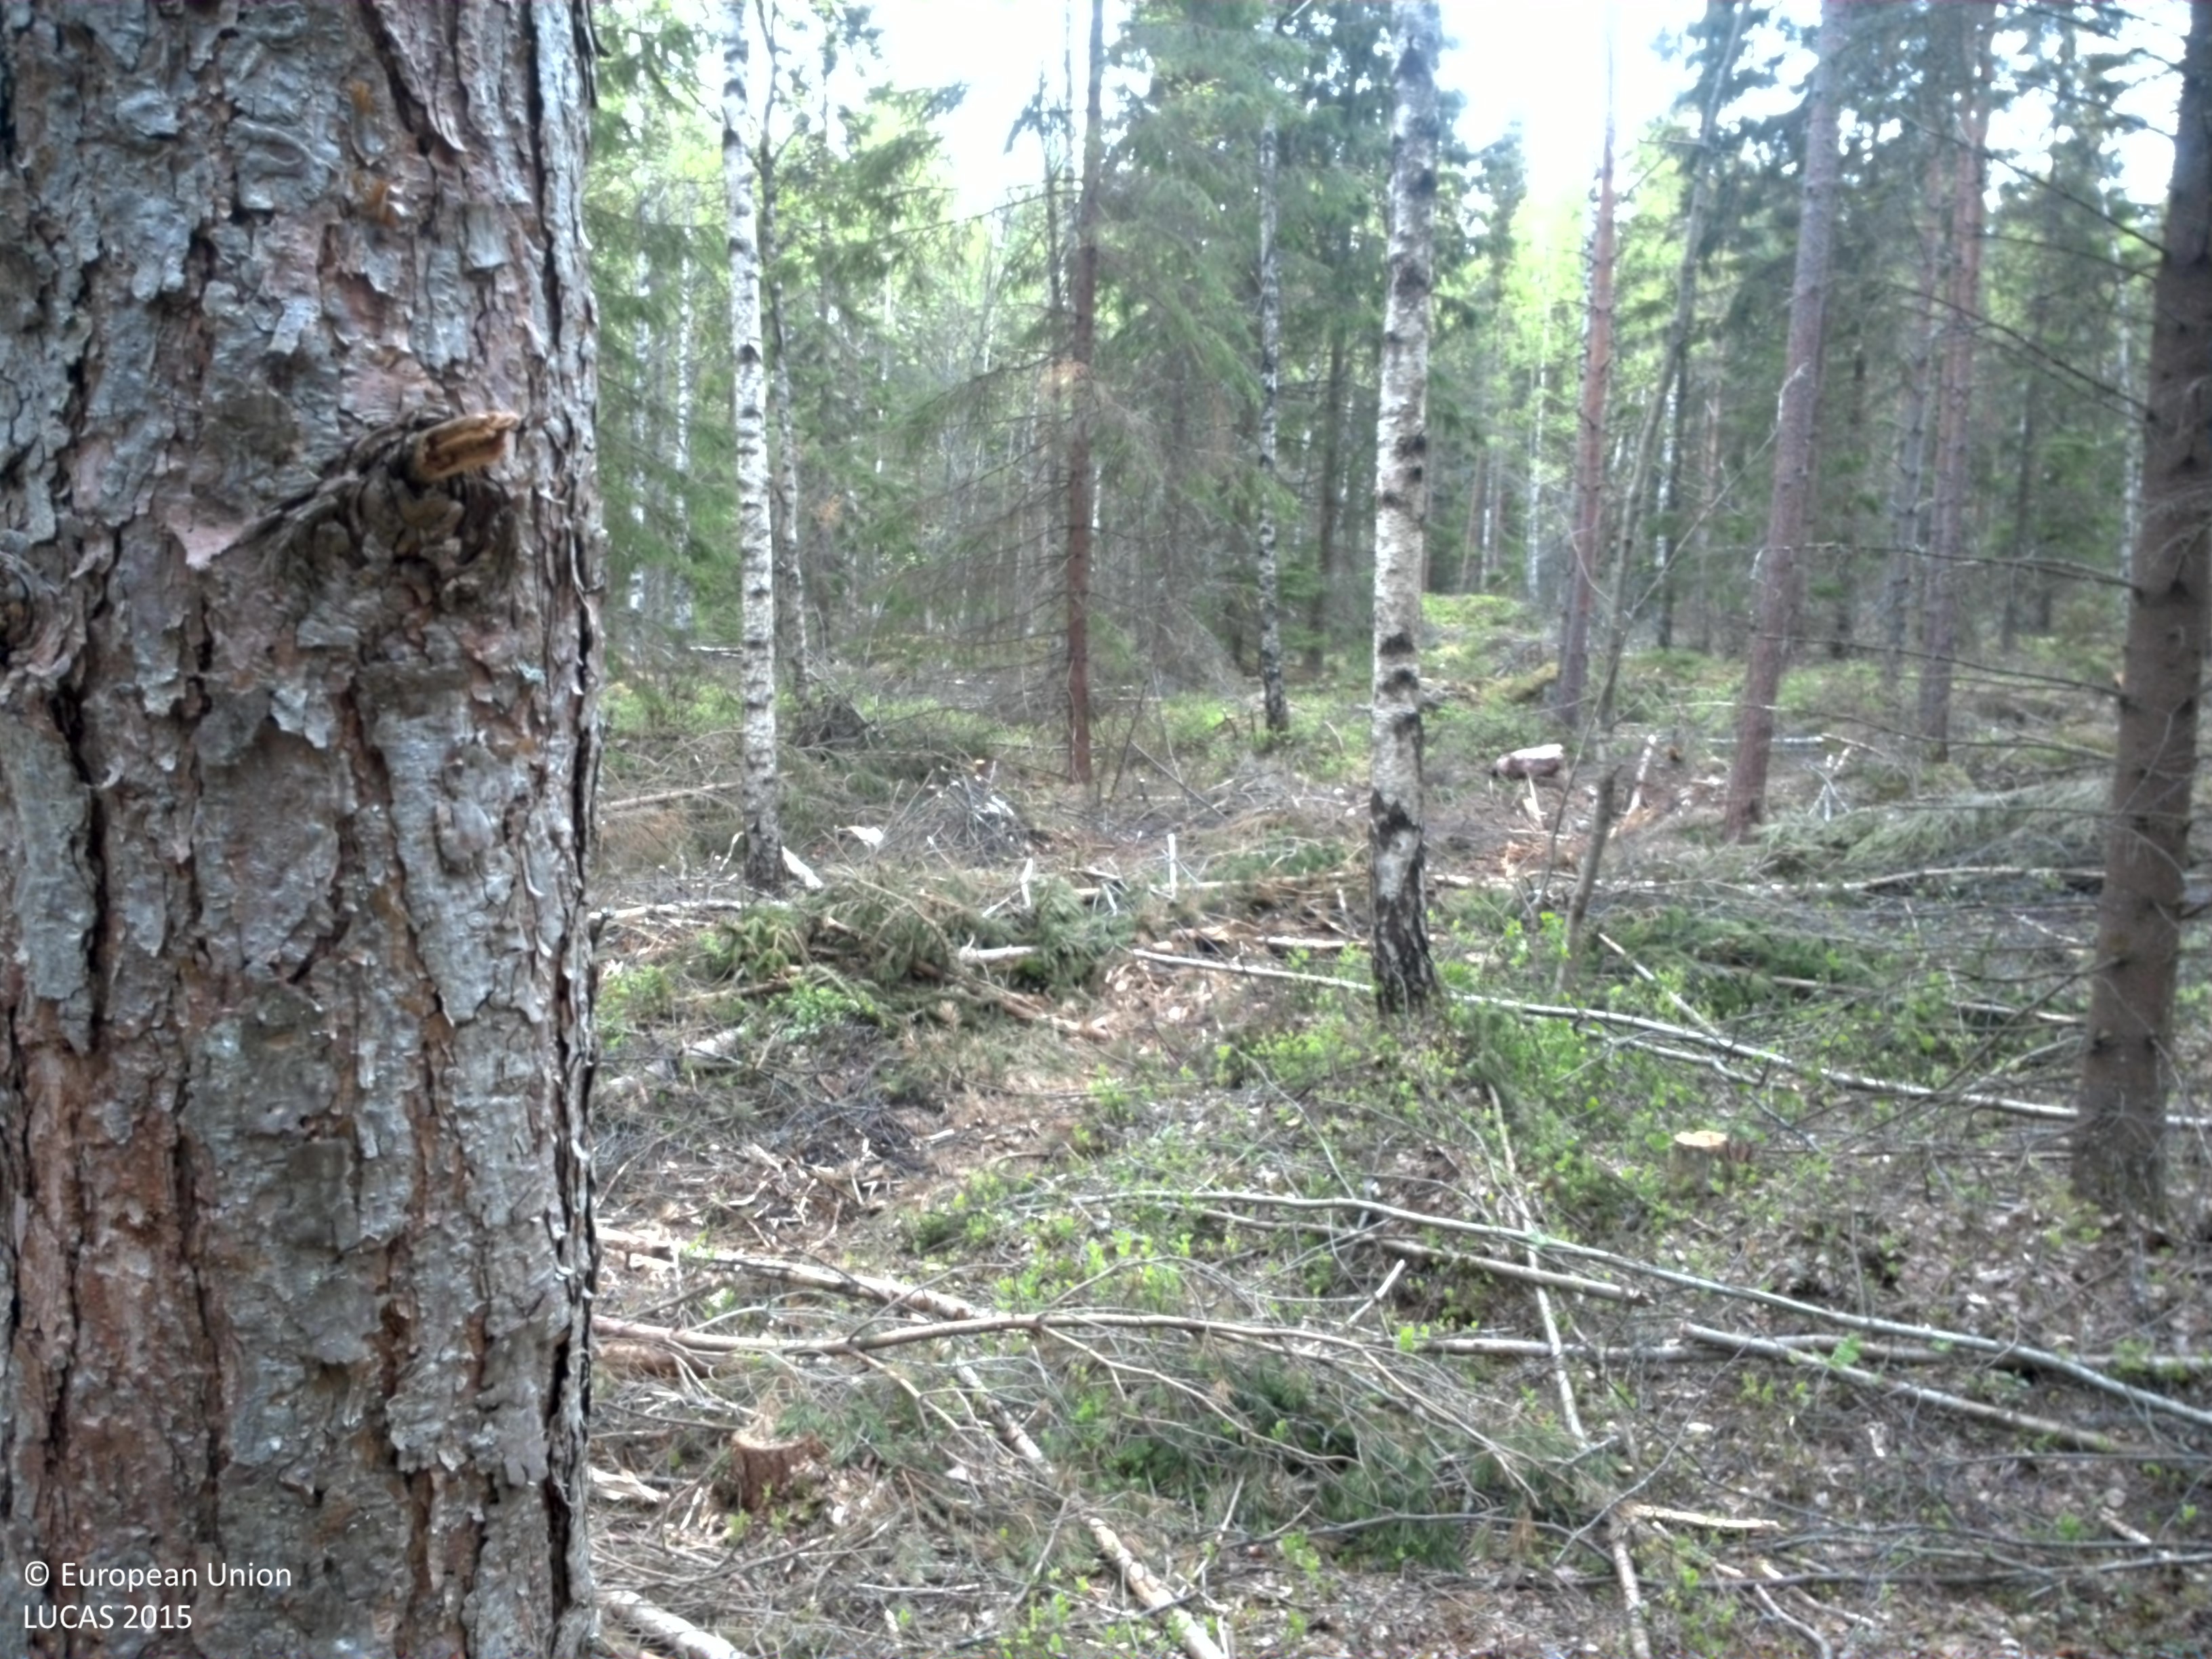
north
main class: Woodland
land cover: Other mixed woodland
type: boreal forest
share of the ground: > 75 %
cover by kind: coniferous forest trees 50 %, broadleaved forest trees 30 %, herbaceous plants 15 %, shrubs 5 %
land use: Forestry
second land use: Amenities, museums, leisure
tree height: > 5 m
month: May
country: SE
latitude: 59.2925
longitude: 14.0824
